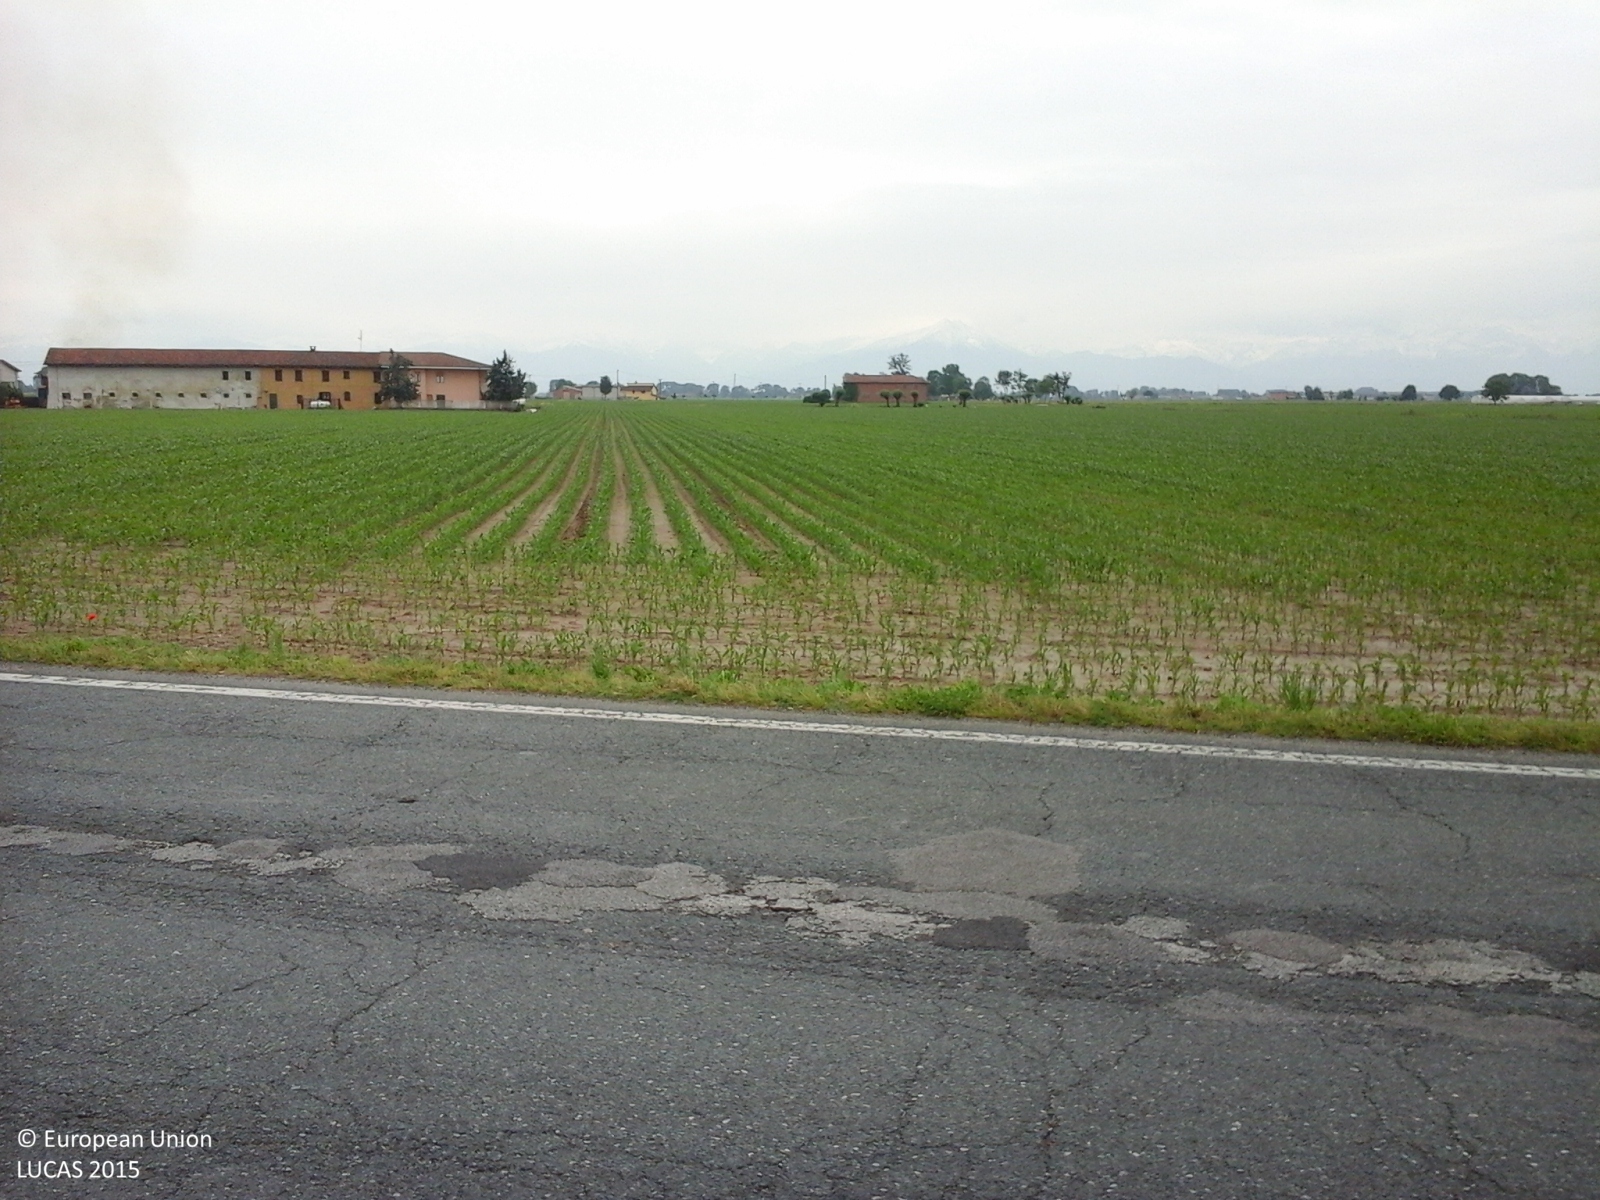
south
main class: Cropland
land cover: Maize
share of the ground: < 10 %
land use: Agriculture (excluding fallow land and kitchen gardens)
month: May
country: IT
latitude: 44.5585
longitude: 7.6505
